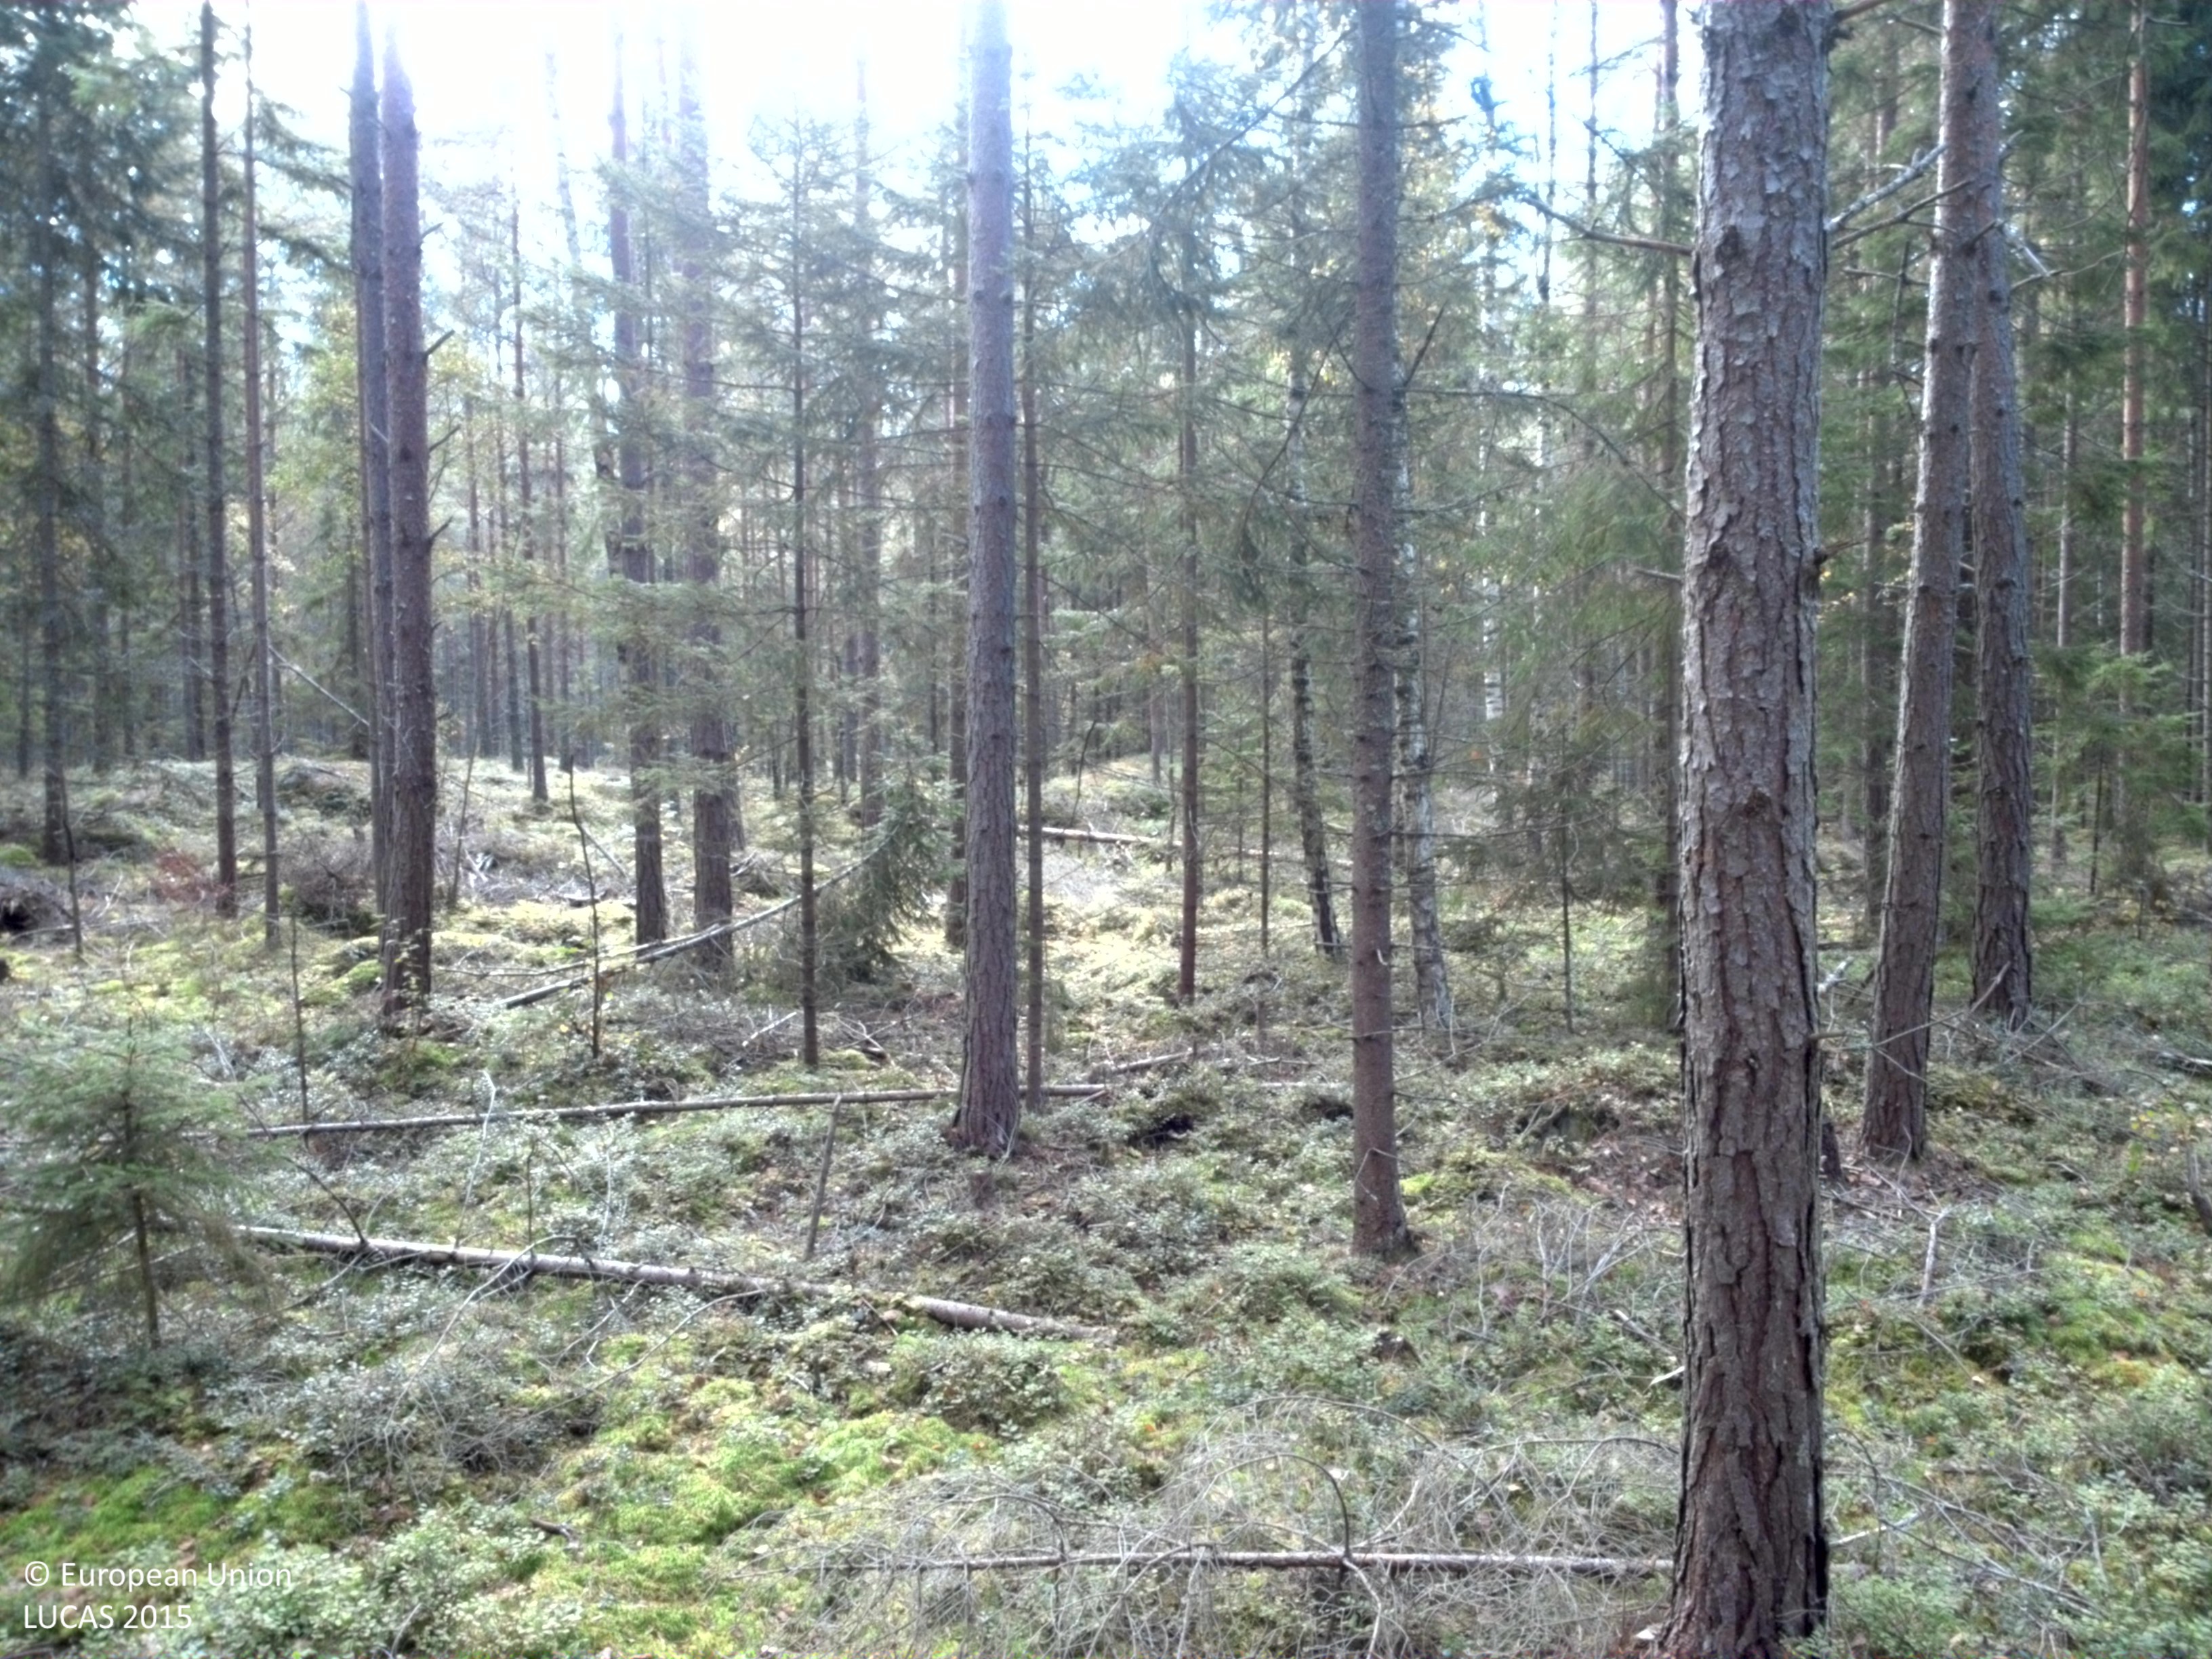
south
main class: Woodland
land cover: Pine dominated mixed woodland
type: boreal forest
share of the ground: 10 - 25 %
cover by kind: shrubs 40 %, lichens and mosses 35 %, coniferous forest trees 15 %, broadleaved forest trees 10 %
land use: Forestry
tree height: > 5 m
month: September
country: SE
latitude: 59.2028
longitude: 14.0719
